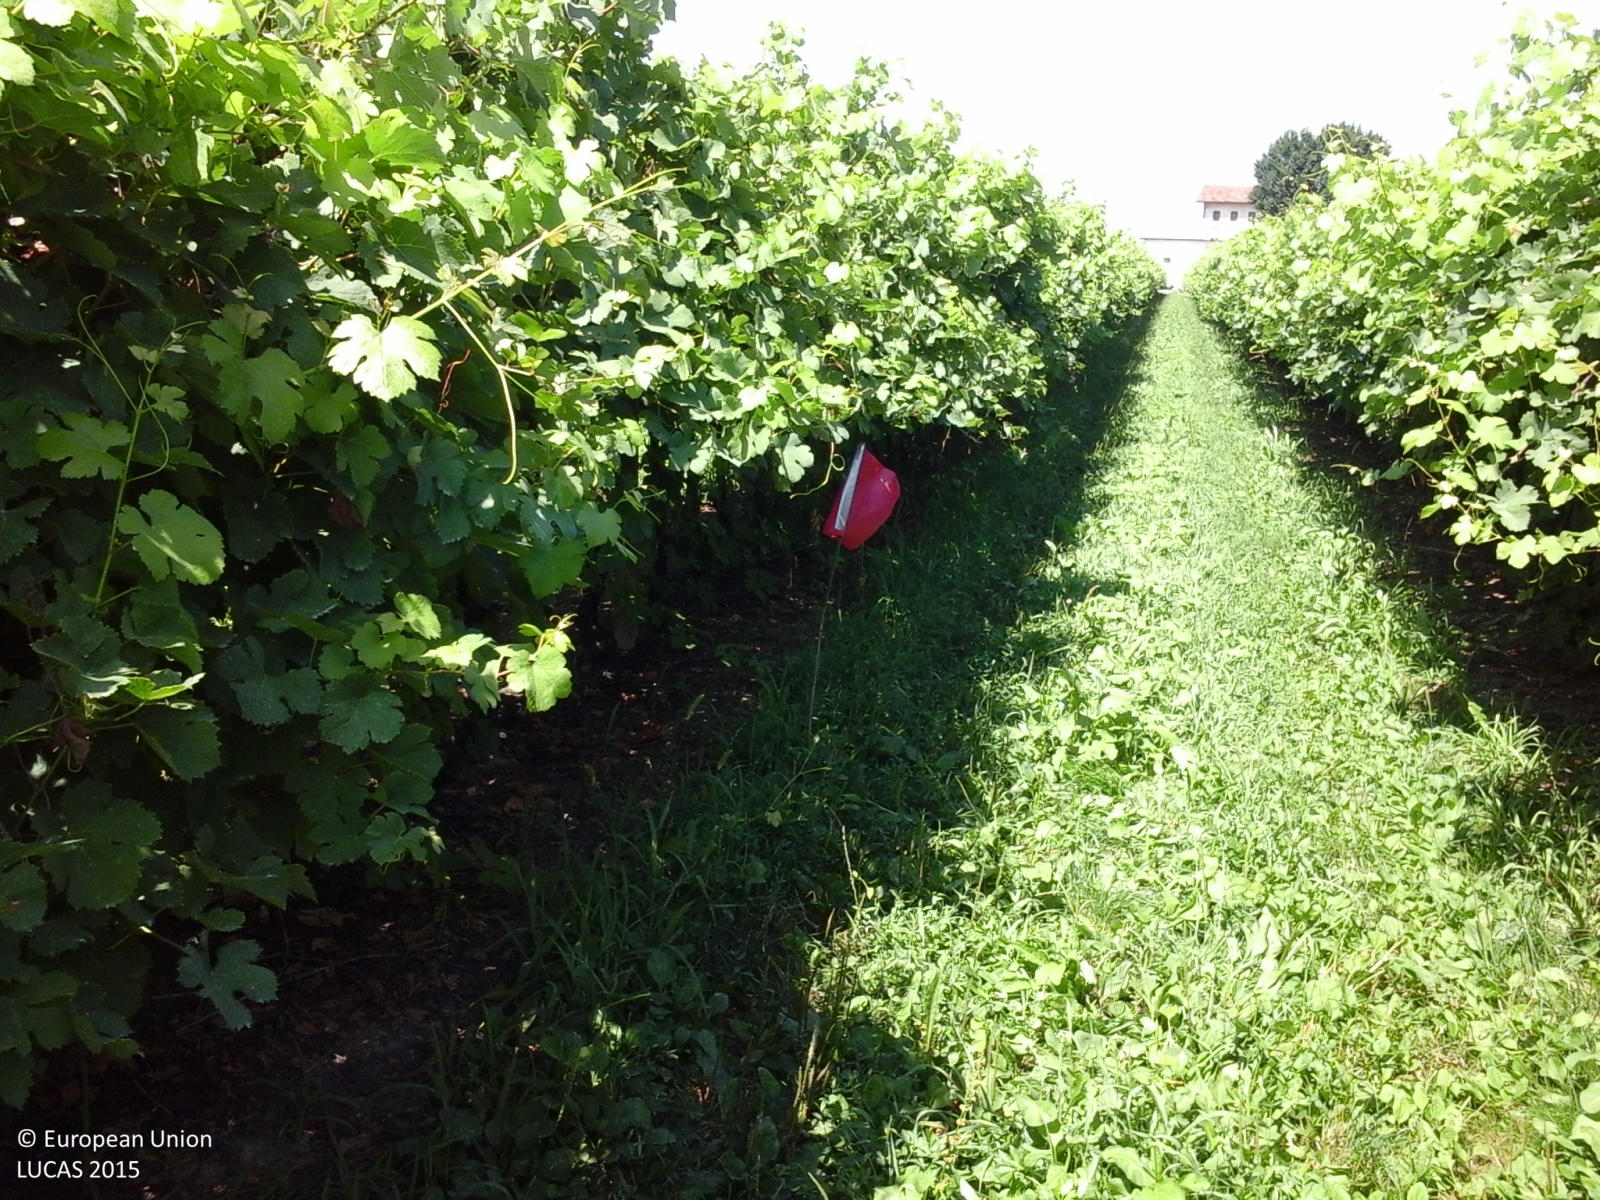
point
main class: Cropland
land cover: Vineyards
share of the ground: 25 - 50 %
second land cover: Grassland without tree/shrub cover
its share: > 75 %
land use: Agriculture (excluding fallow land and kitchen gardens)
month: July
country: IT
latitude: 45.8038
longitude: 12.3000
